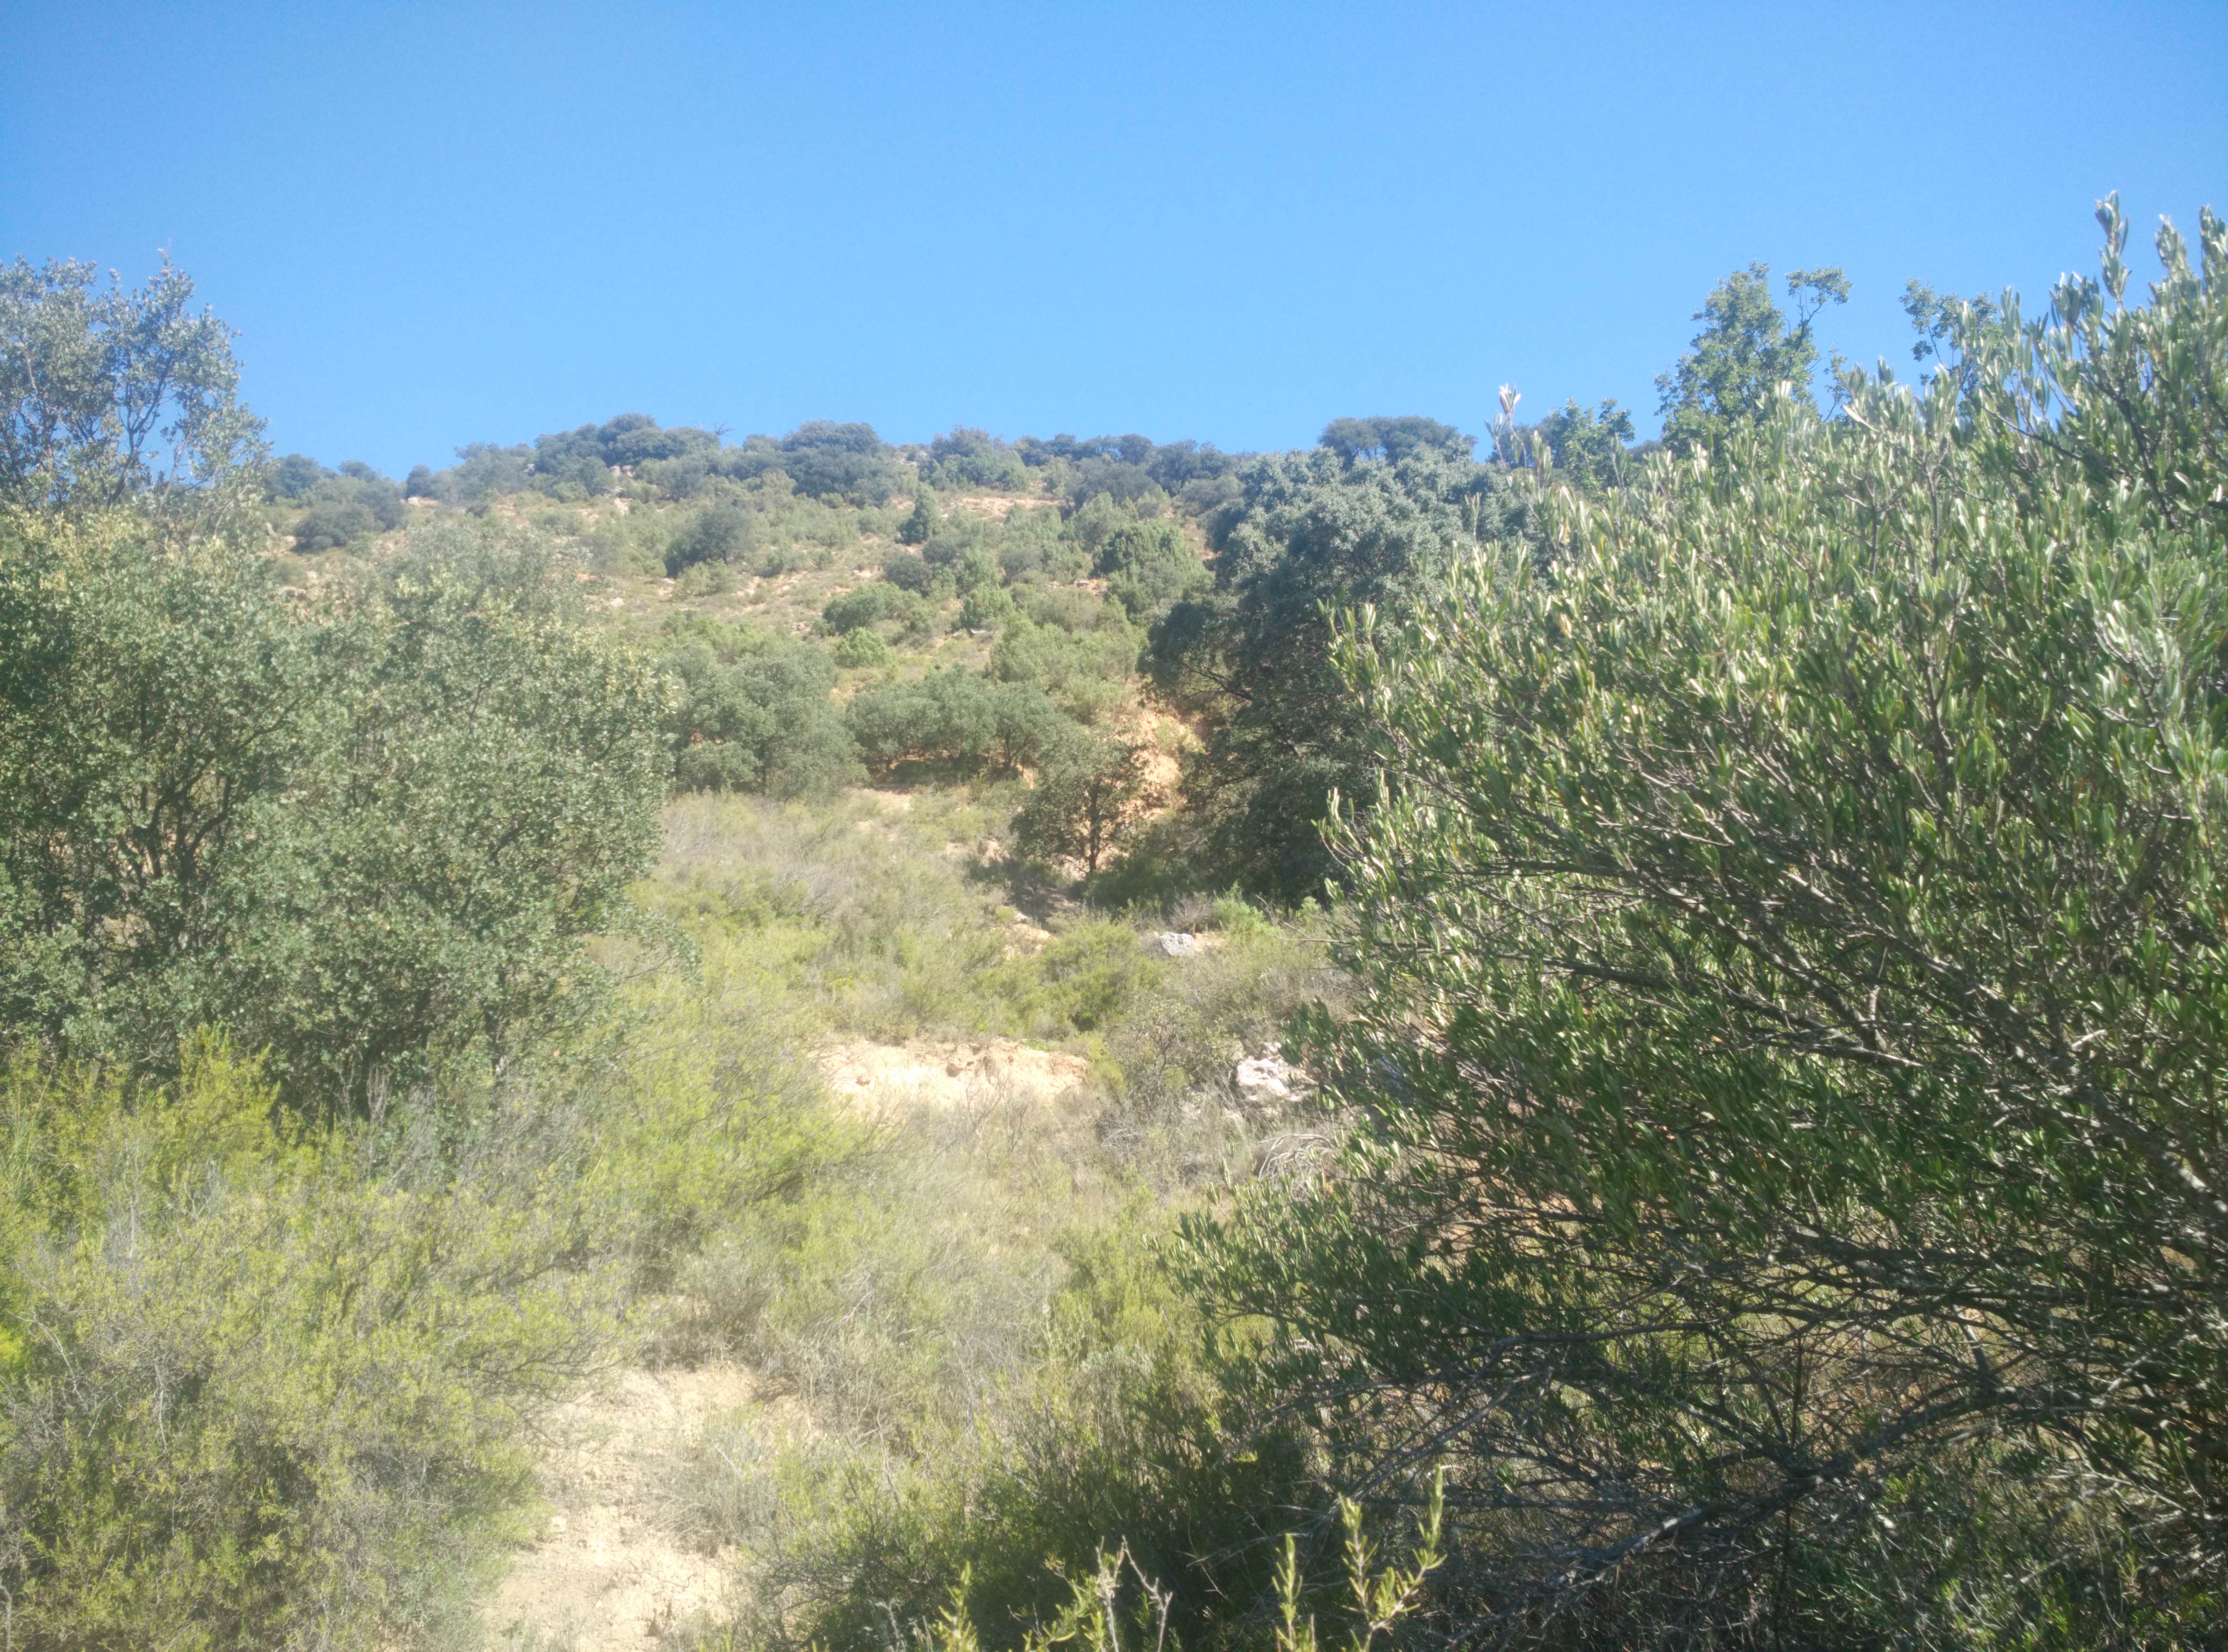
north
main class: Cropland
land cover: Olive groves
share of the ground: 10 - 25 %
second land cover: Shrubland without tree cover
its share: 50 - 75 %
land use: Agriculture (excluding fallow land and kitchen gardens)
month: July
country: ES
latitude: 40.7378
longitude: -2.8316
